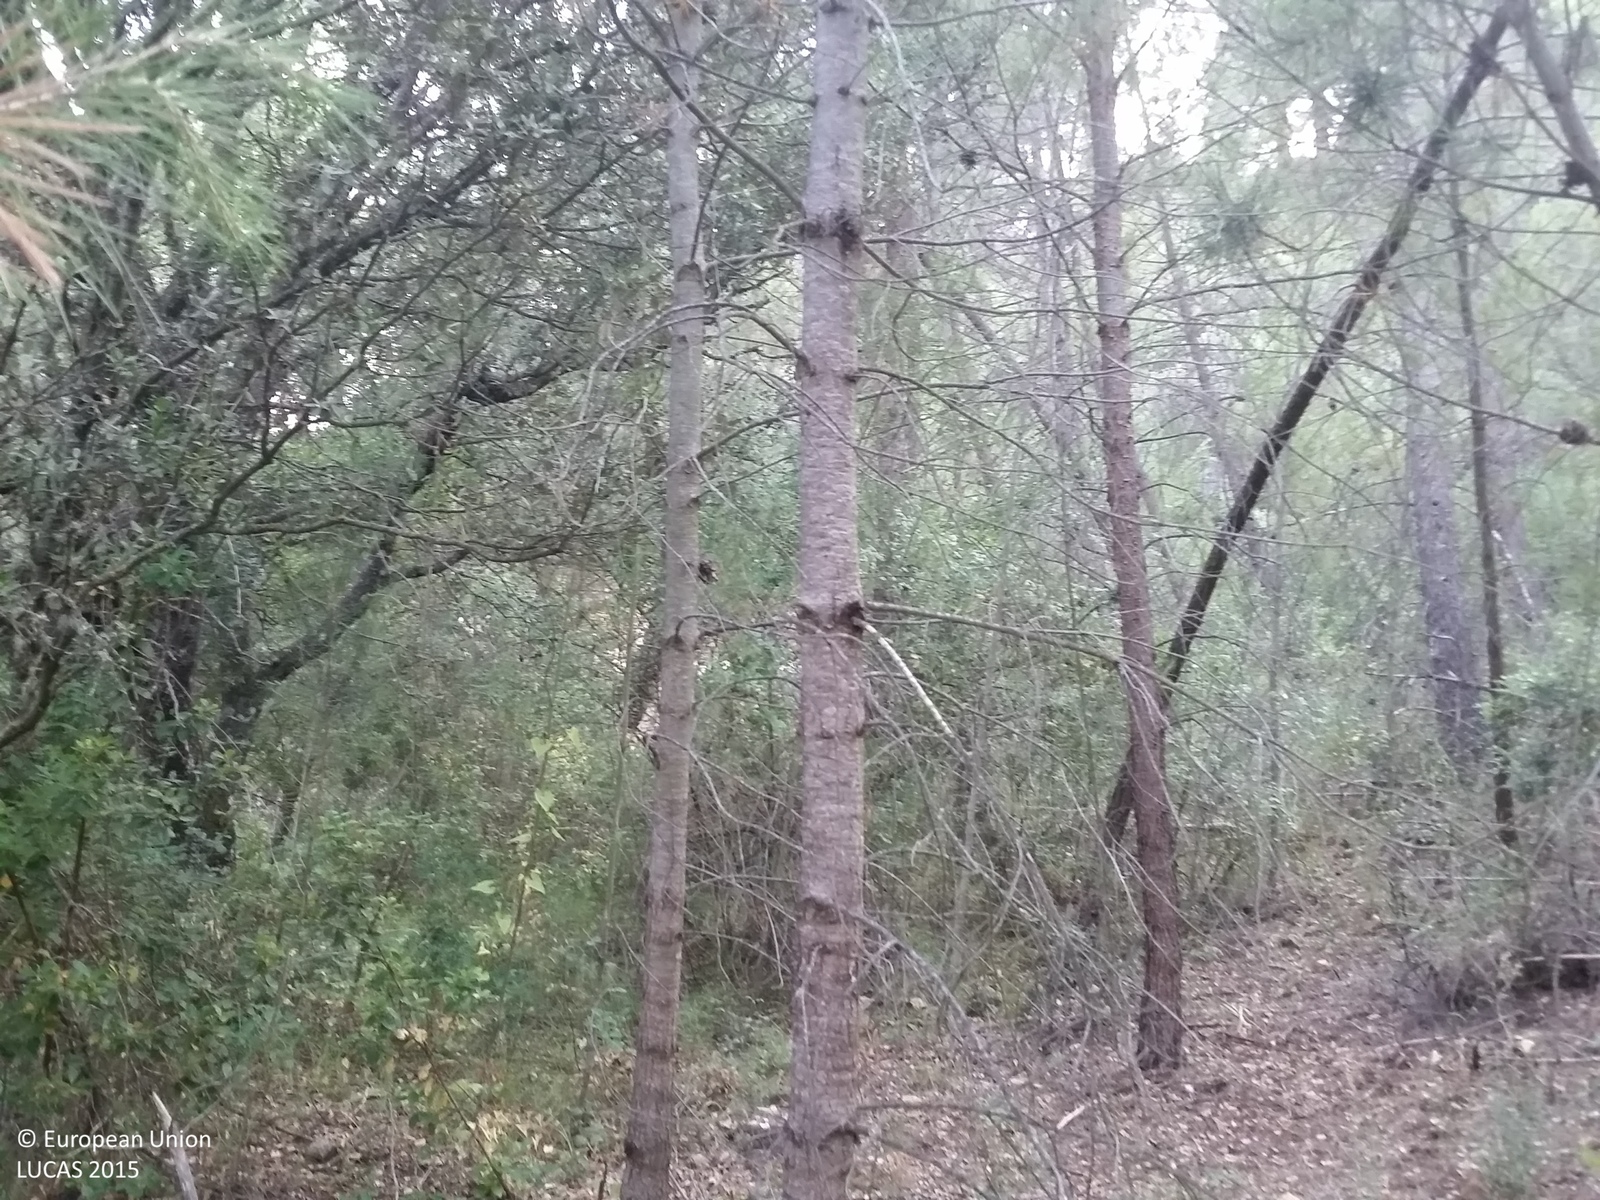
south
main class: Woodland
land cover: Other mixed woodland
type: coniferous forest of the mediterranean region
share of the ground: > 75 %
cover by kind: coniferous forest trees 35 %, broadleaved forest trees 35 %, shrubs 25 %, herbaceous plants 5 %
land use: Semi-natural and natural areas not in use
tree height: > 5 m
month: July
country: ES
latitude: 38.3745
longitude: -2.4392
